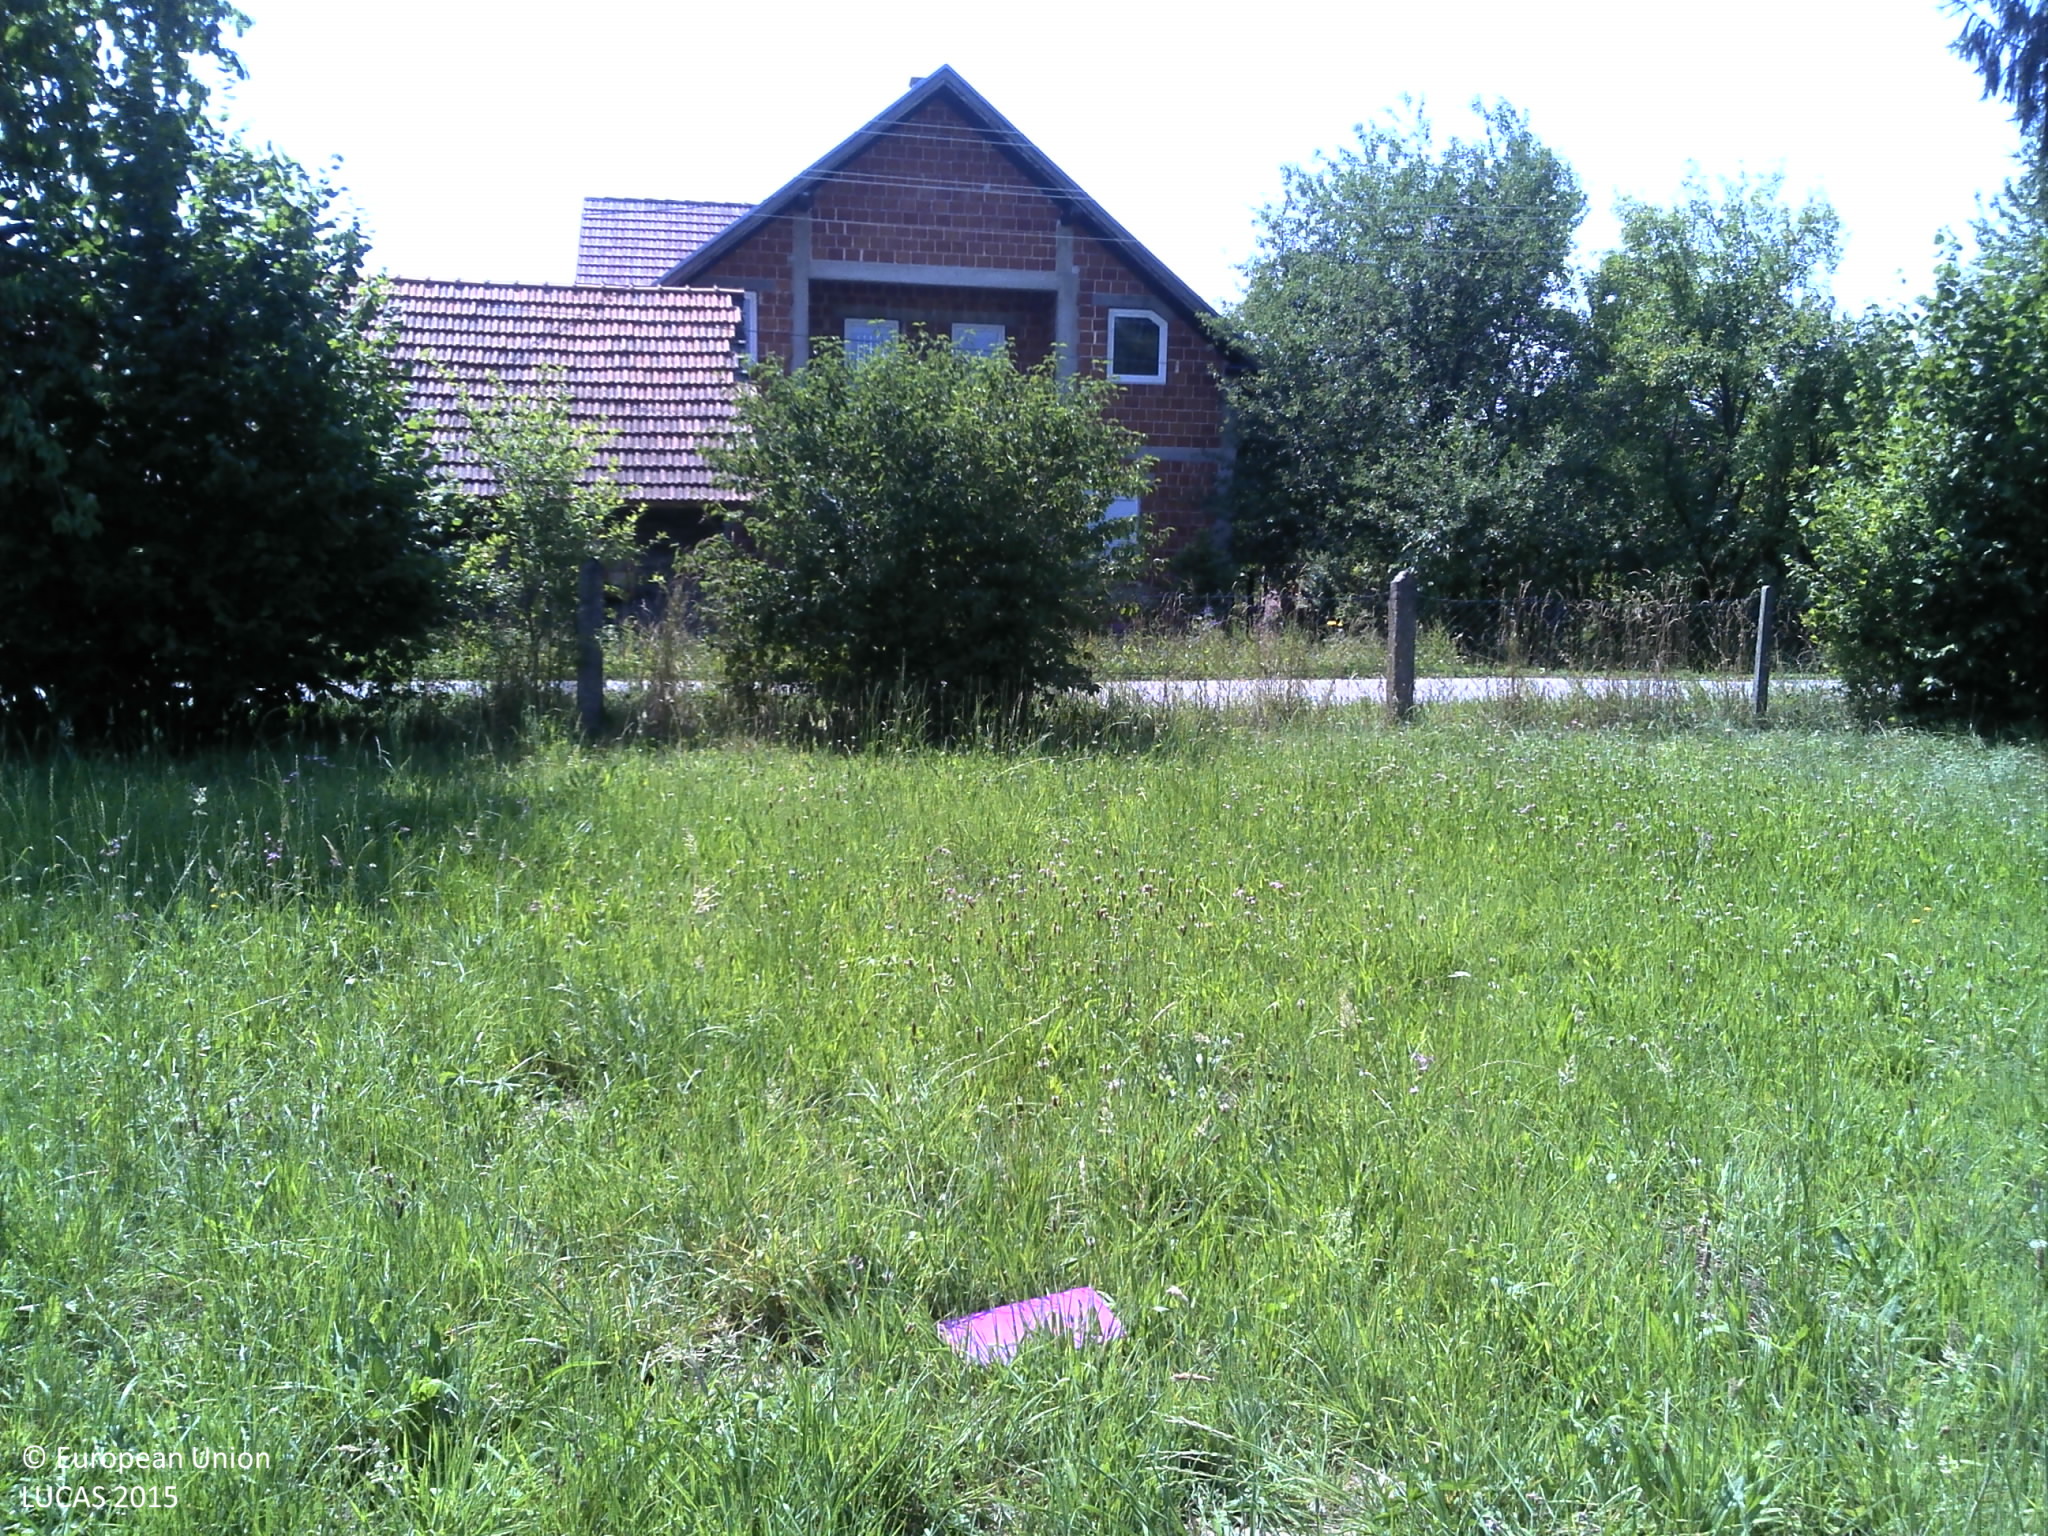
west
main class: Grassland
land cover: Grassland without tree/shrub cover
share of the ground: > 75 %
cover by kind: herbaceous plants 100 %
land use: Semi-natural and natural areas not in use
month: July
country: HR
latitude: 45.7649
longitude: 16.6471
